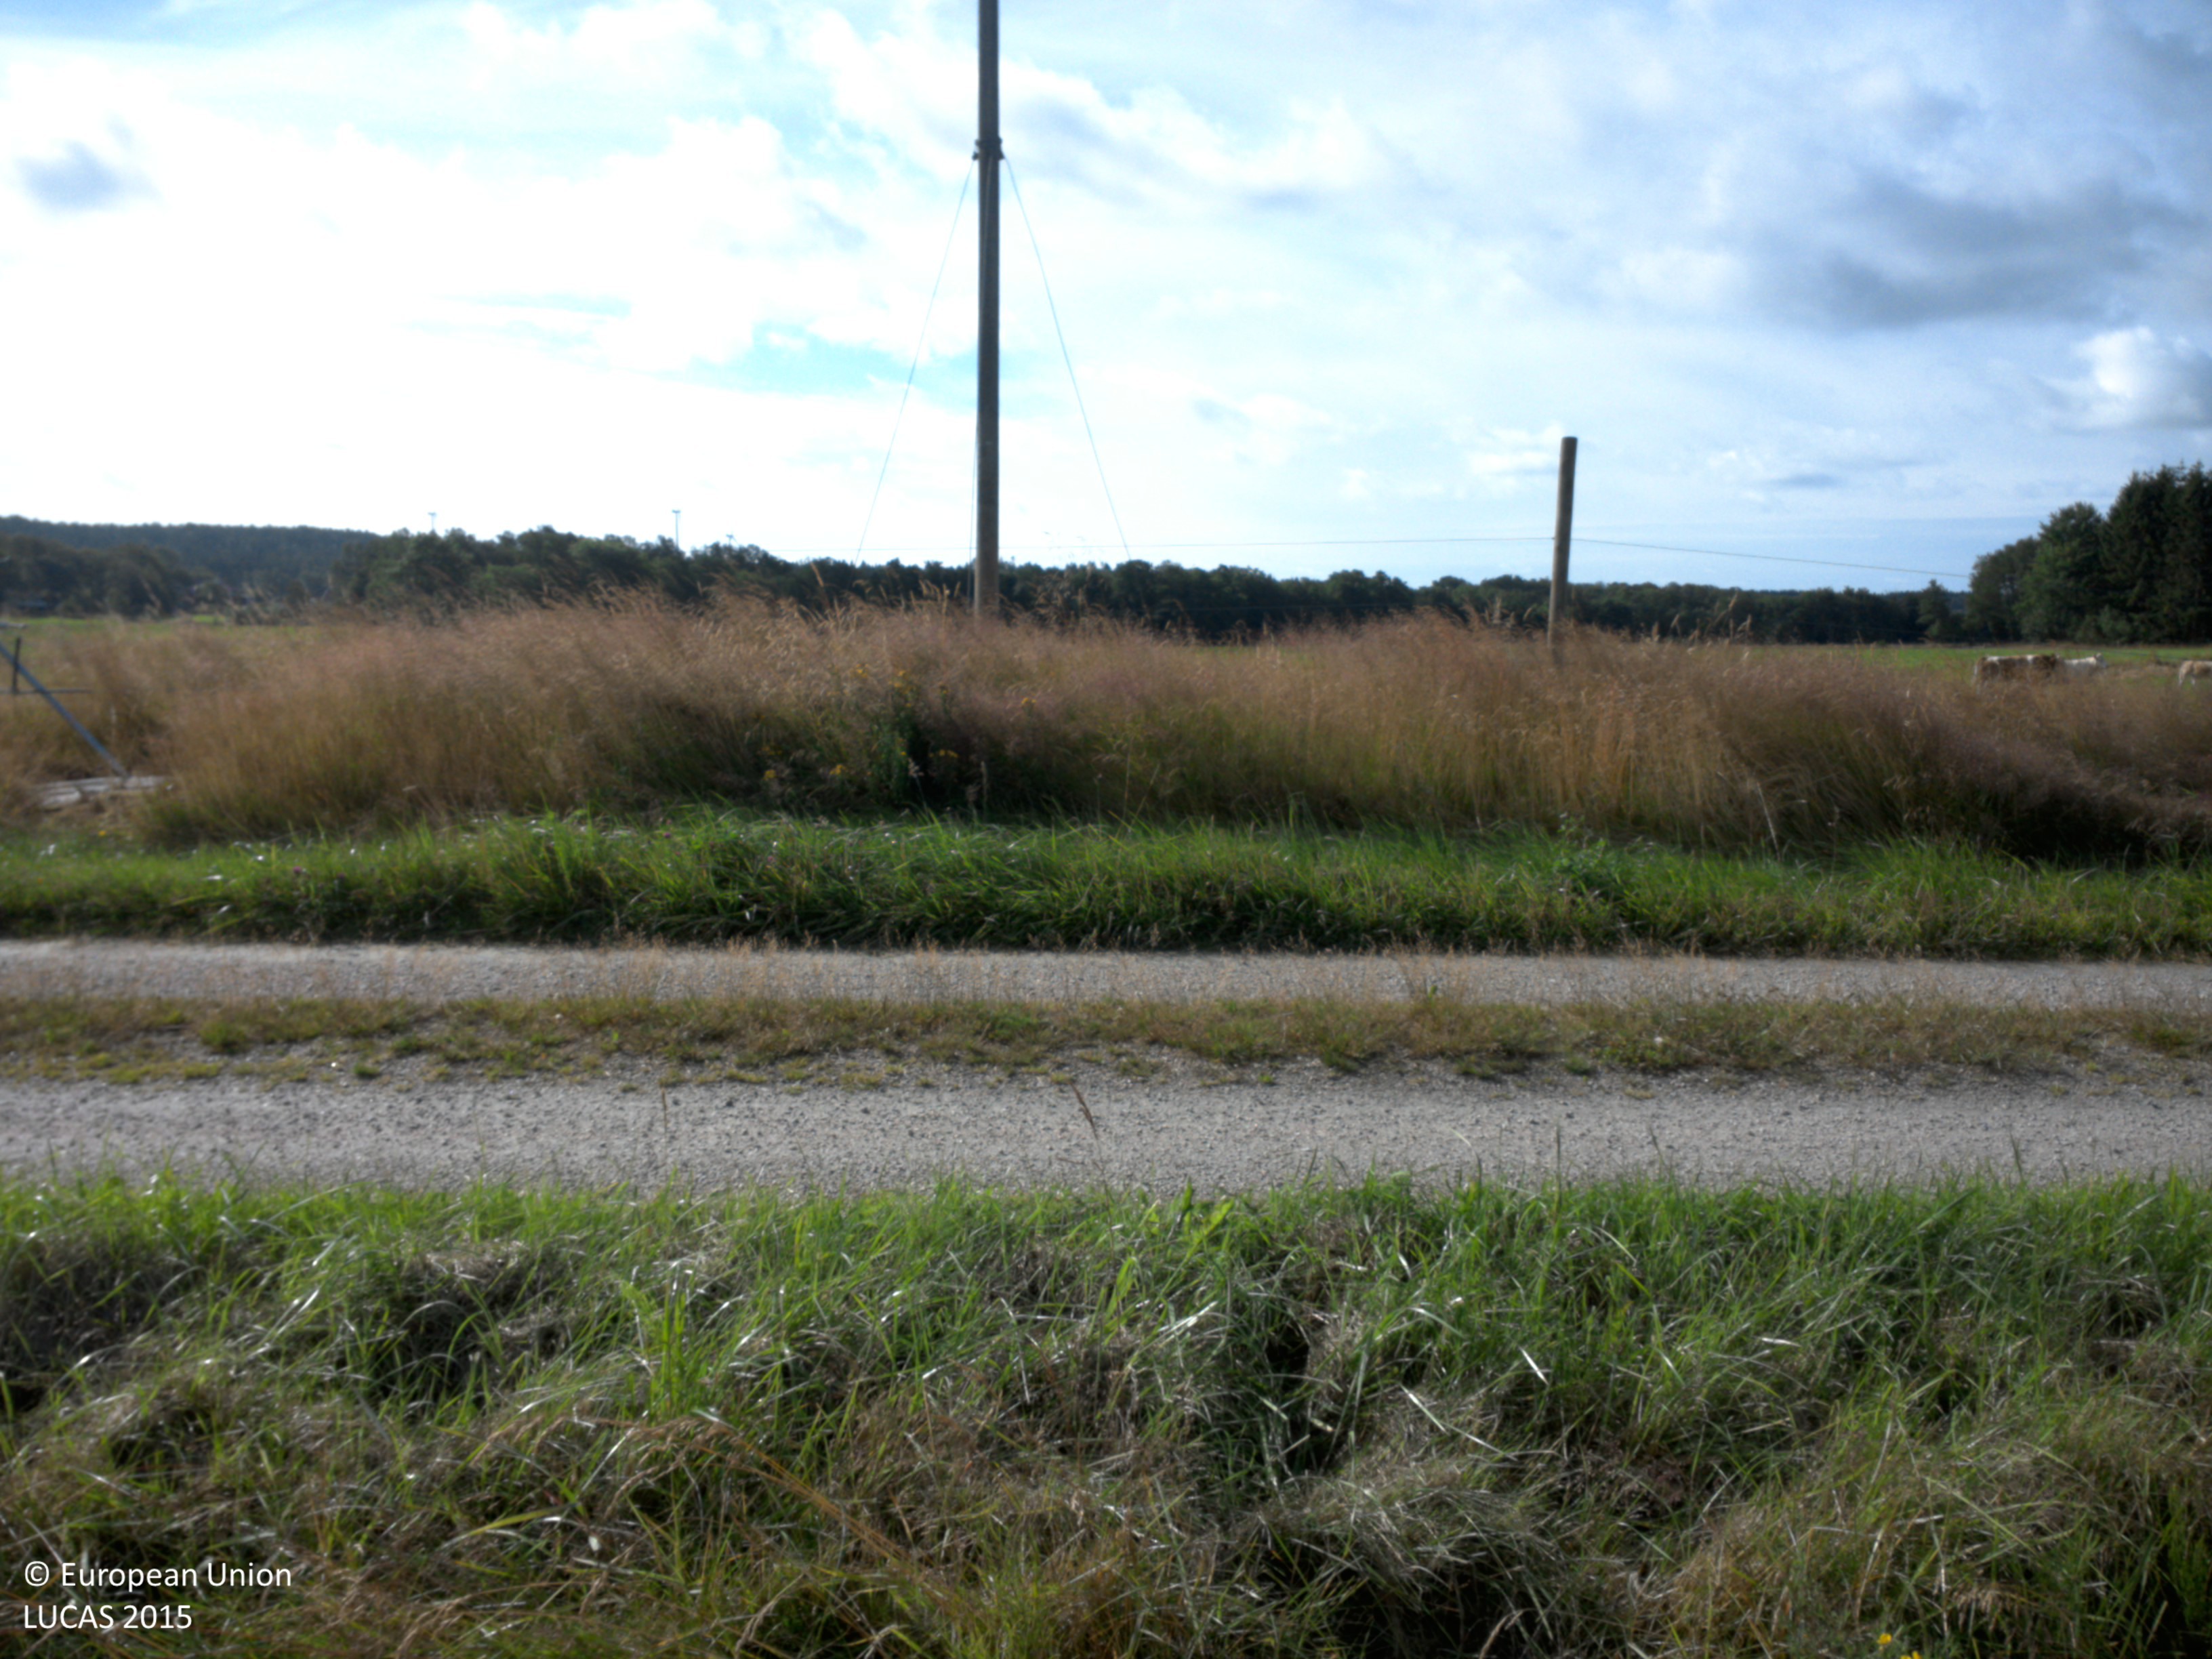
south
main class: Cropland
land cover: Temporary grasslands
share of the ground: > 75 %
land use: Agriculture (excluding fallow land and kitchen gardens)
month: July
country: SE
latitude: 58.1918
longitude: 11.6128
